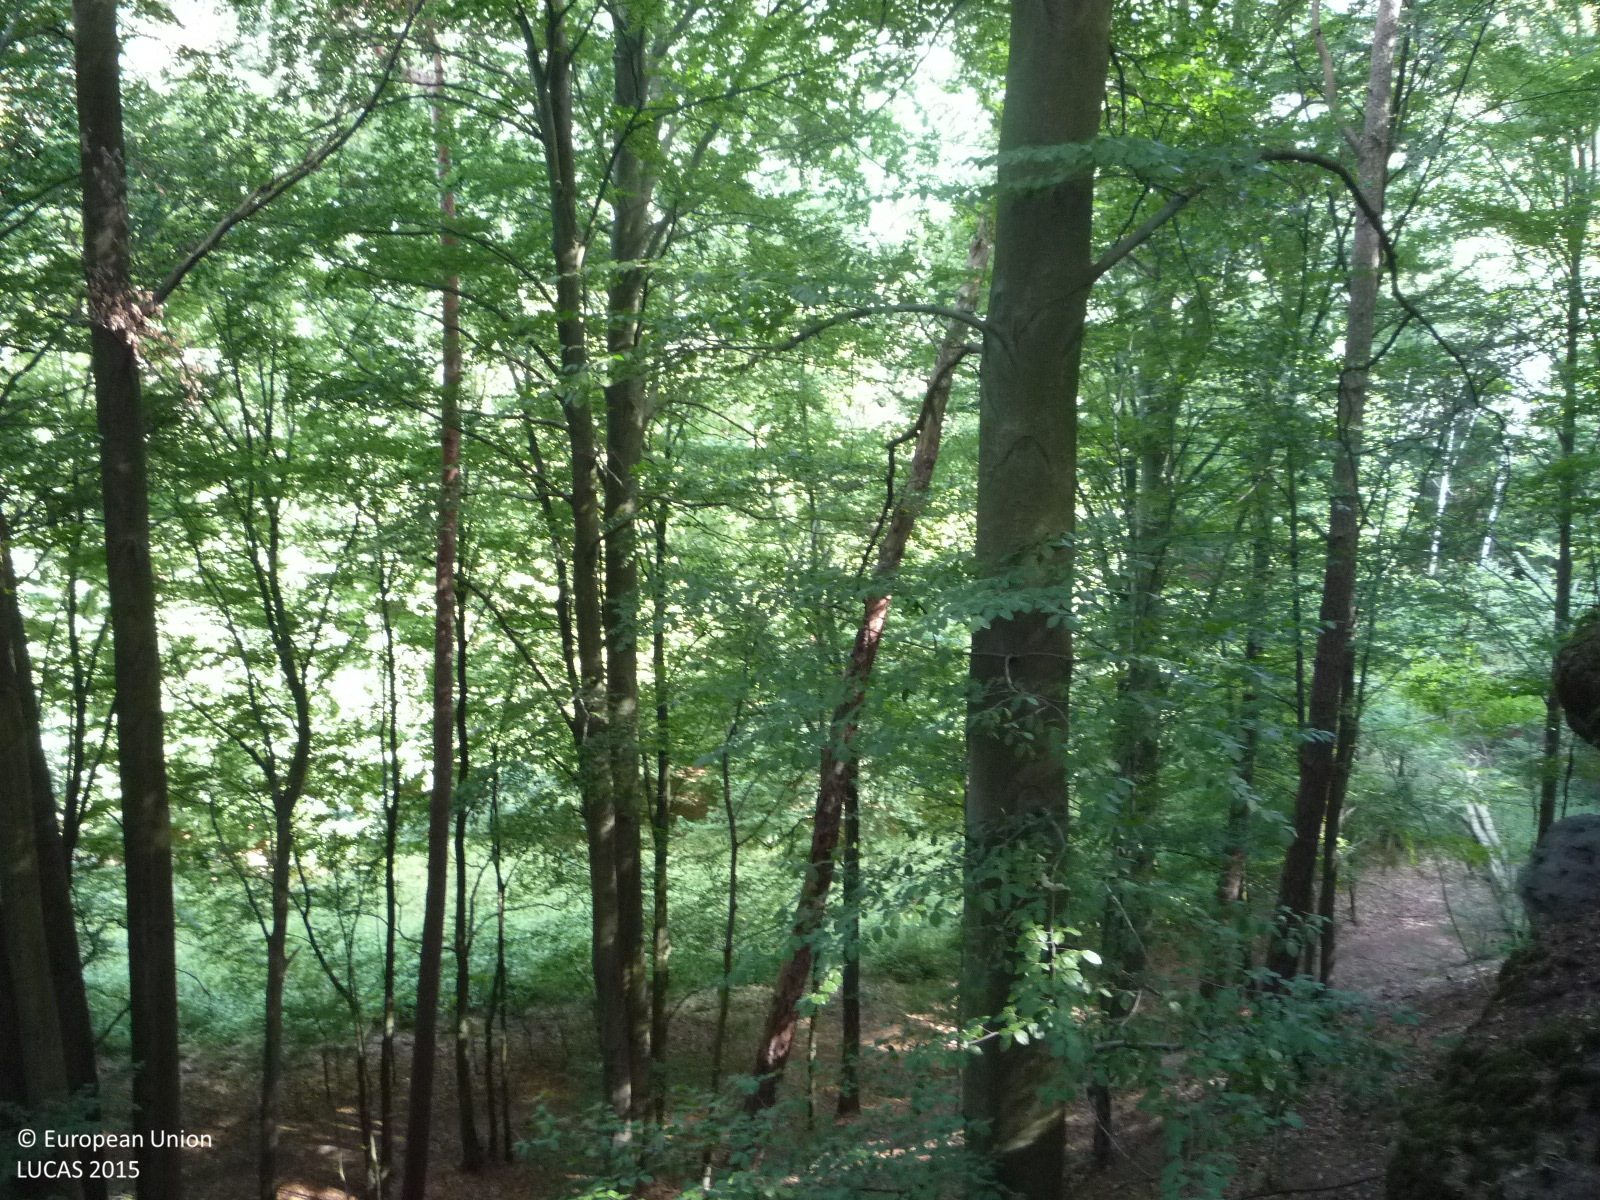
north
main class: Woodland
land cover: Pine dominated mixed woodland
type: hemiboreal forest and nemoral coniferous forest and mixed broadleaved-coniferous forest
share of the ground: > 75 %
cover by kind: broadleaved forest trees 60 %, coniferous forest trees 40 %
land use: Forestry
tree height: > 5 m
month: July
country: CZ
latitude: 50.5254
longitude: 14.5581
